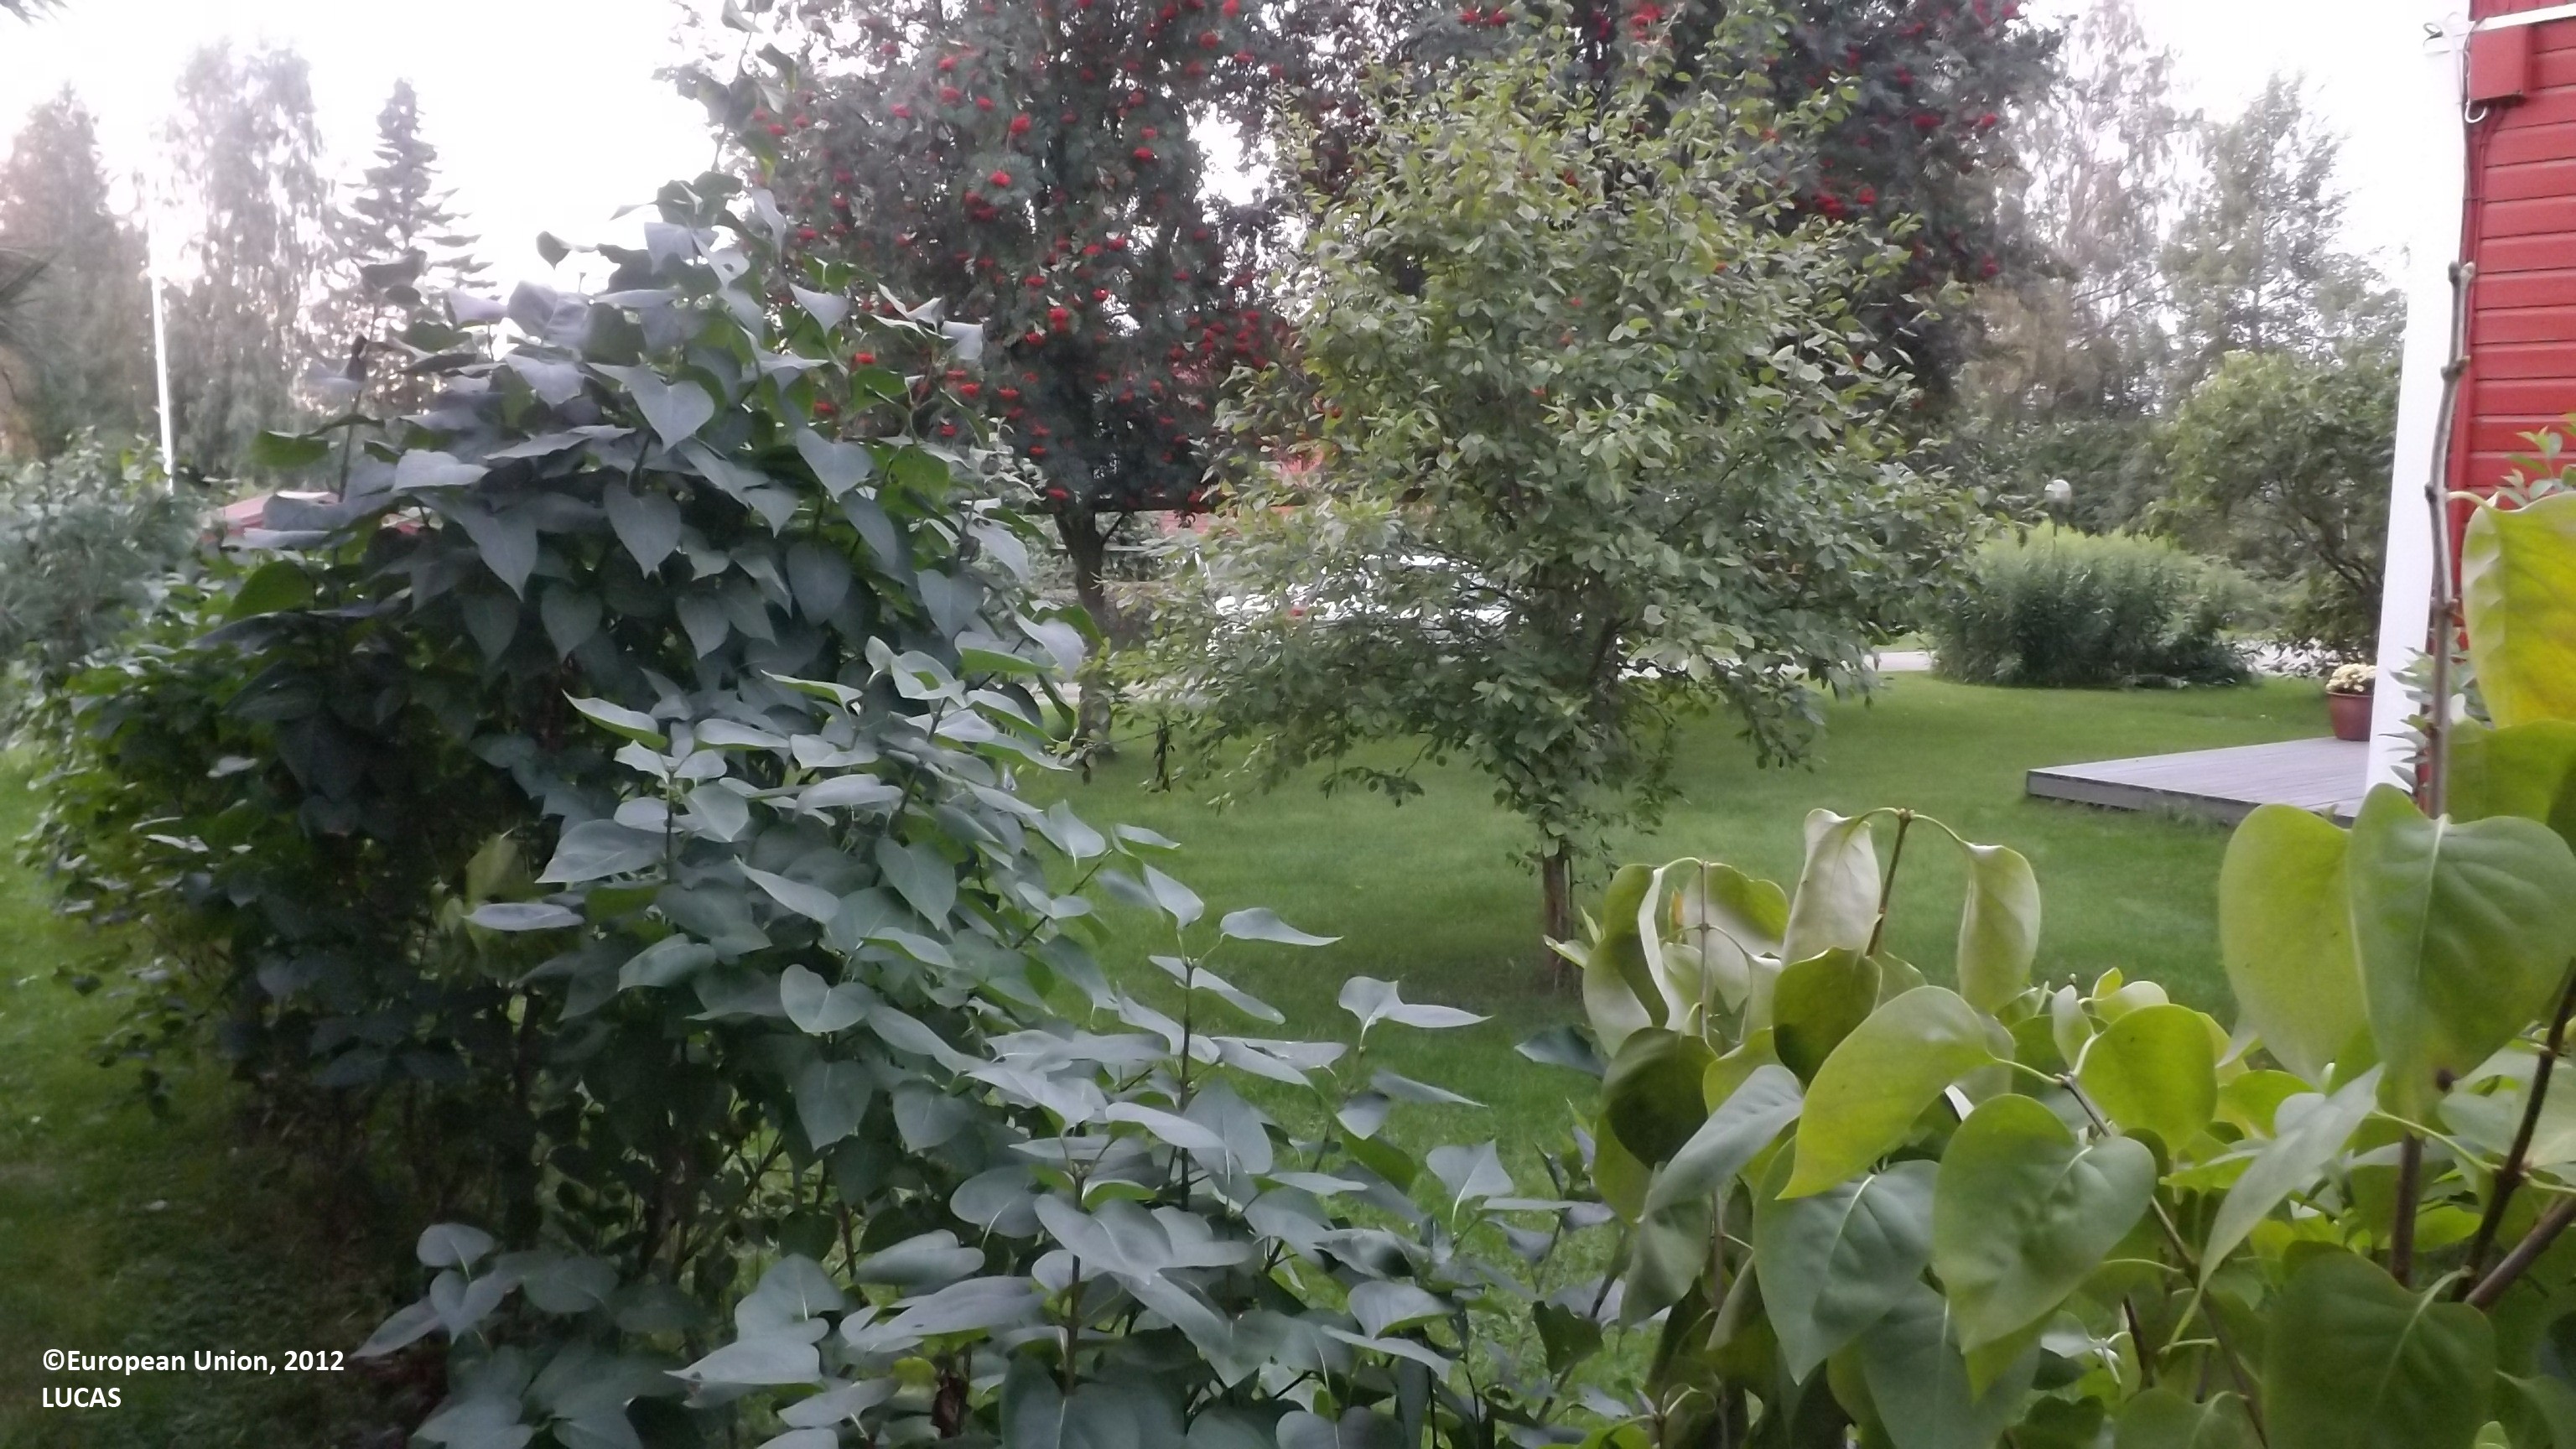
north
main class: Grassland
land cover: Grassland with sparse tree/shrub cover
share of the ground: 25 - 50 %
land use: Residential
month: August
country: FI
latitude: 63.8579
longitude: 23.4637
